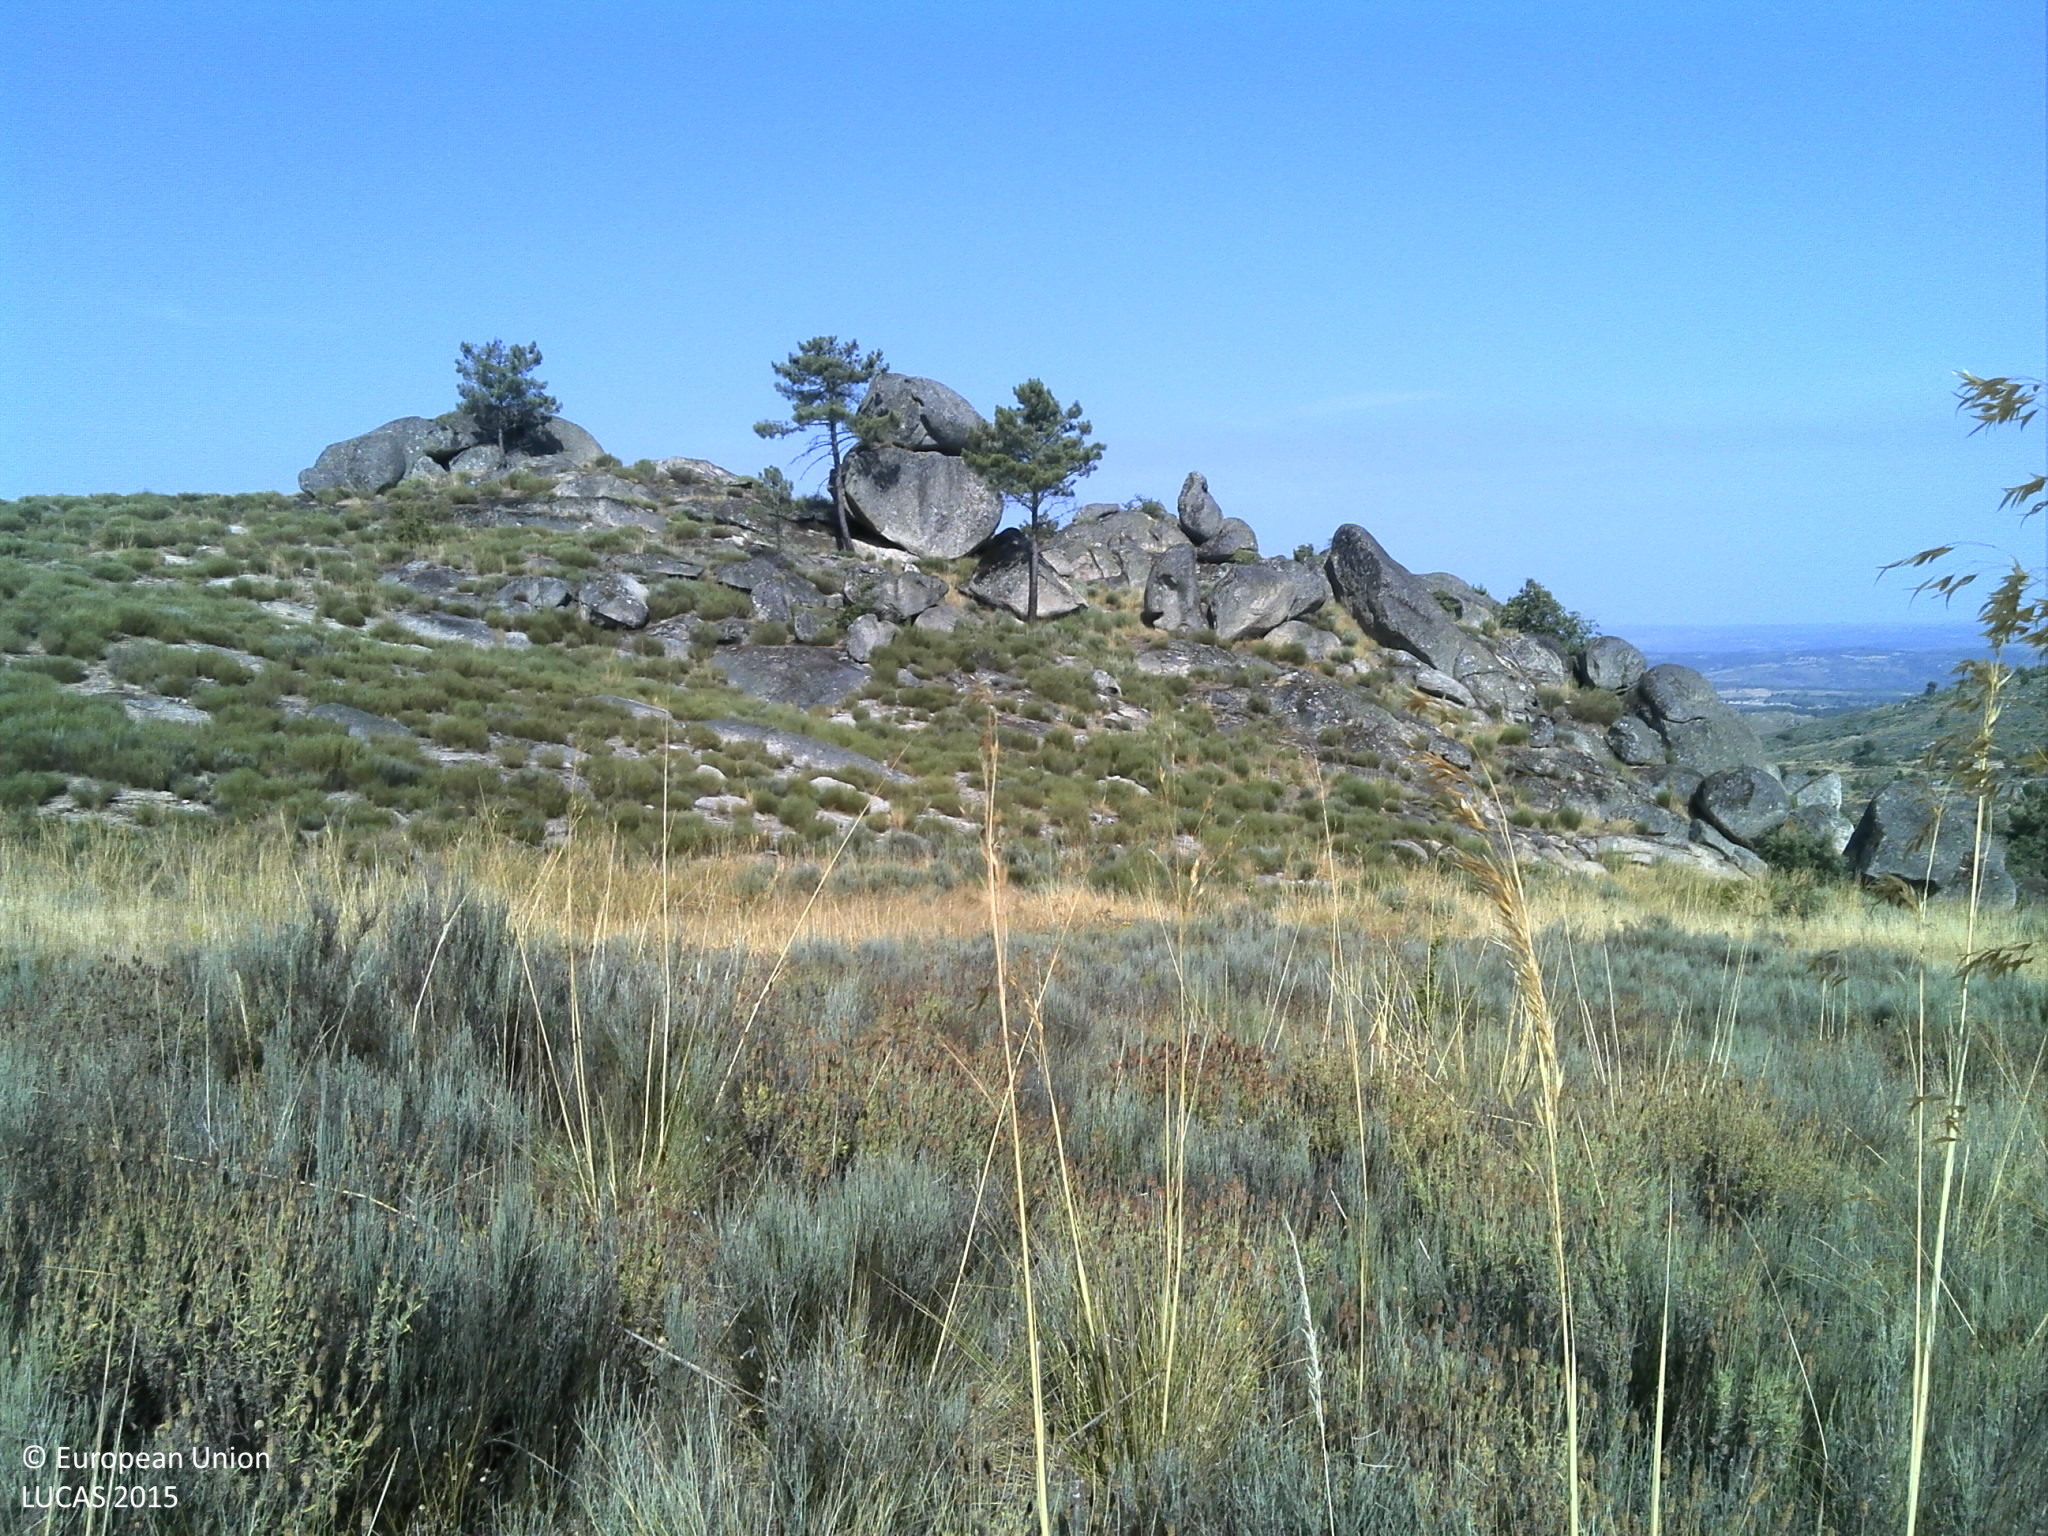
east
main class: Shrubland
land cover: Shrubland without tree cover
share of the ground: 25 - 50 %
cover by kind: shrubs 40 %, unconsolidated bare surface 30 %, consolidated bare surface 20 %, herbaceous plants 10 %
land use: Semi-natural and natural areas not in use
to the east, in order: Shrubland without tree cover; Grassland without tree/shrub cover; Shrubland without tree cover; Rock outcrops; Rocks and stones; Rock outcrops; Rocks and stones; Shrubland without tree cover; Shrubland with sparse tree cover; Shrubland without tree cover; Shrubland with sparse tree cover
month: July
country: PT
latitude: 40.8744
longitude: -7.3061
